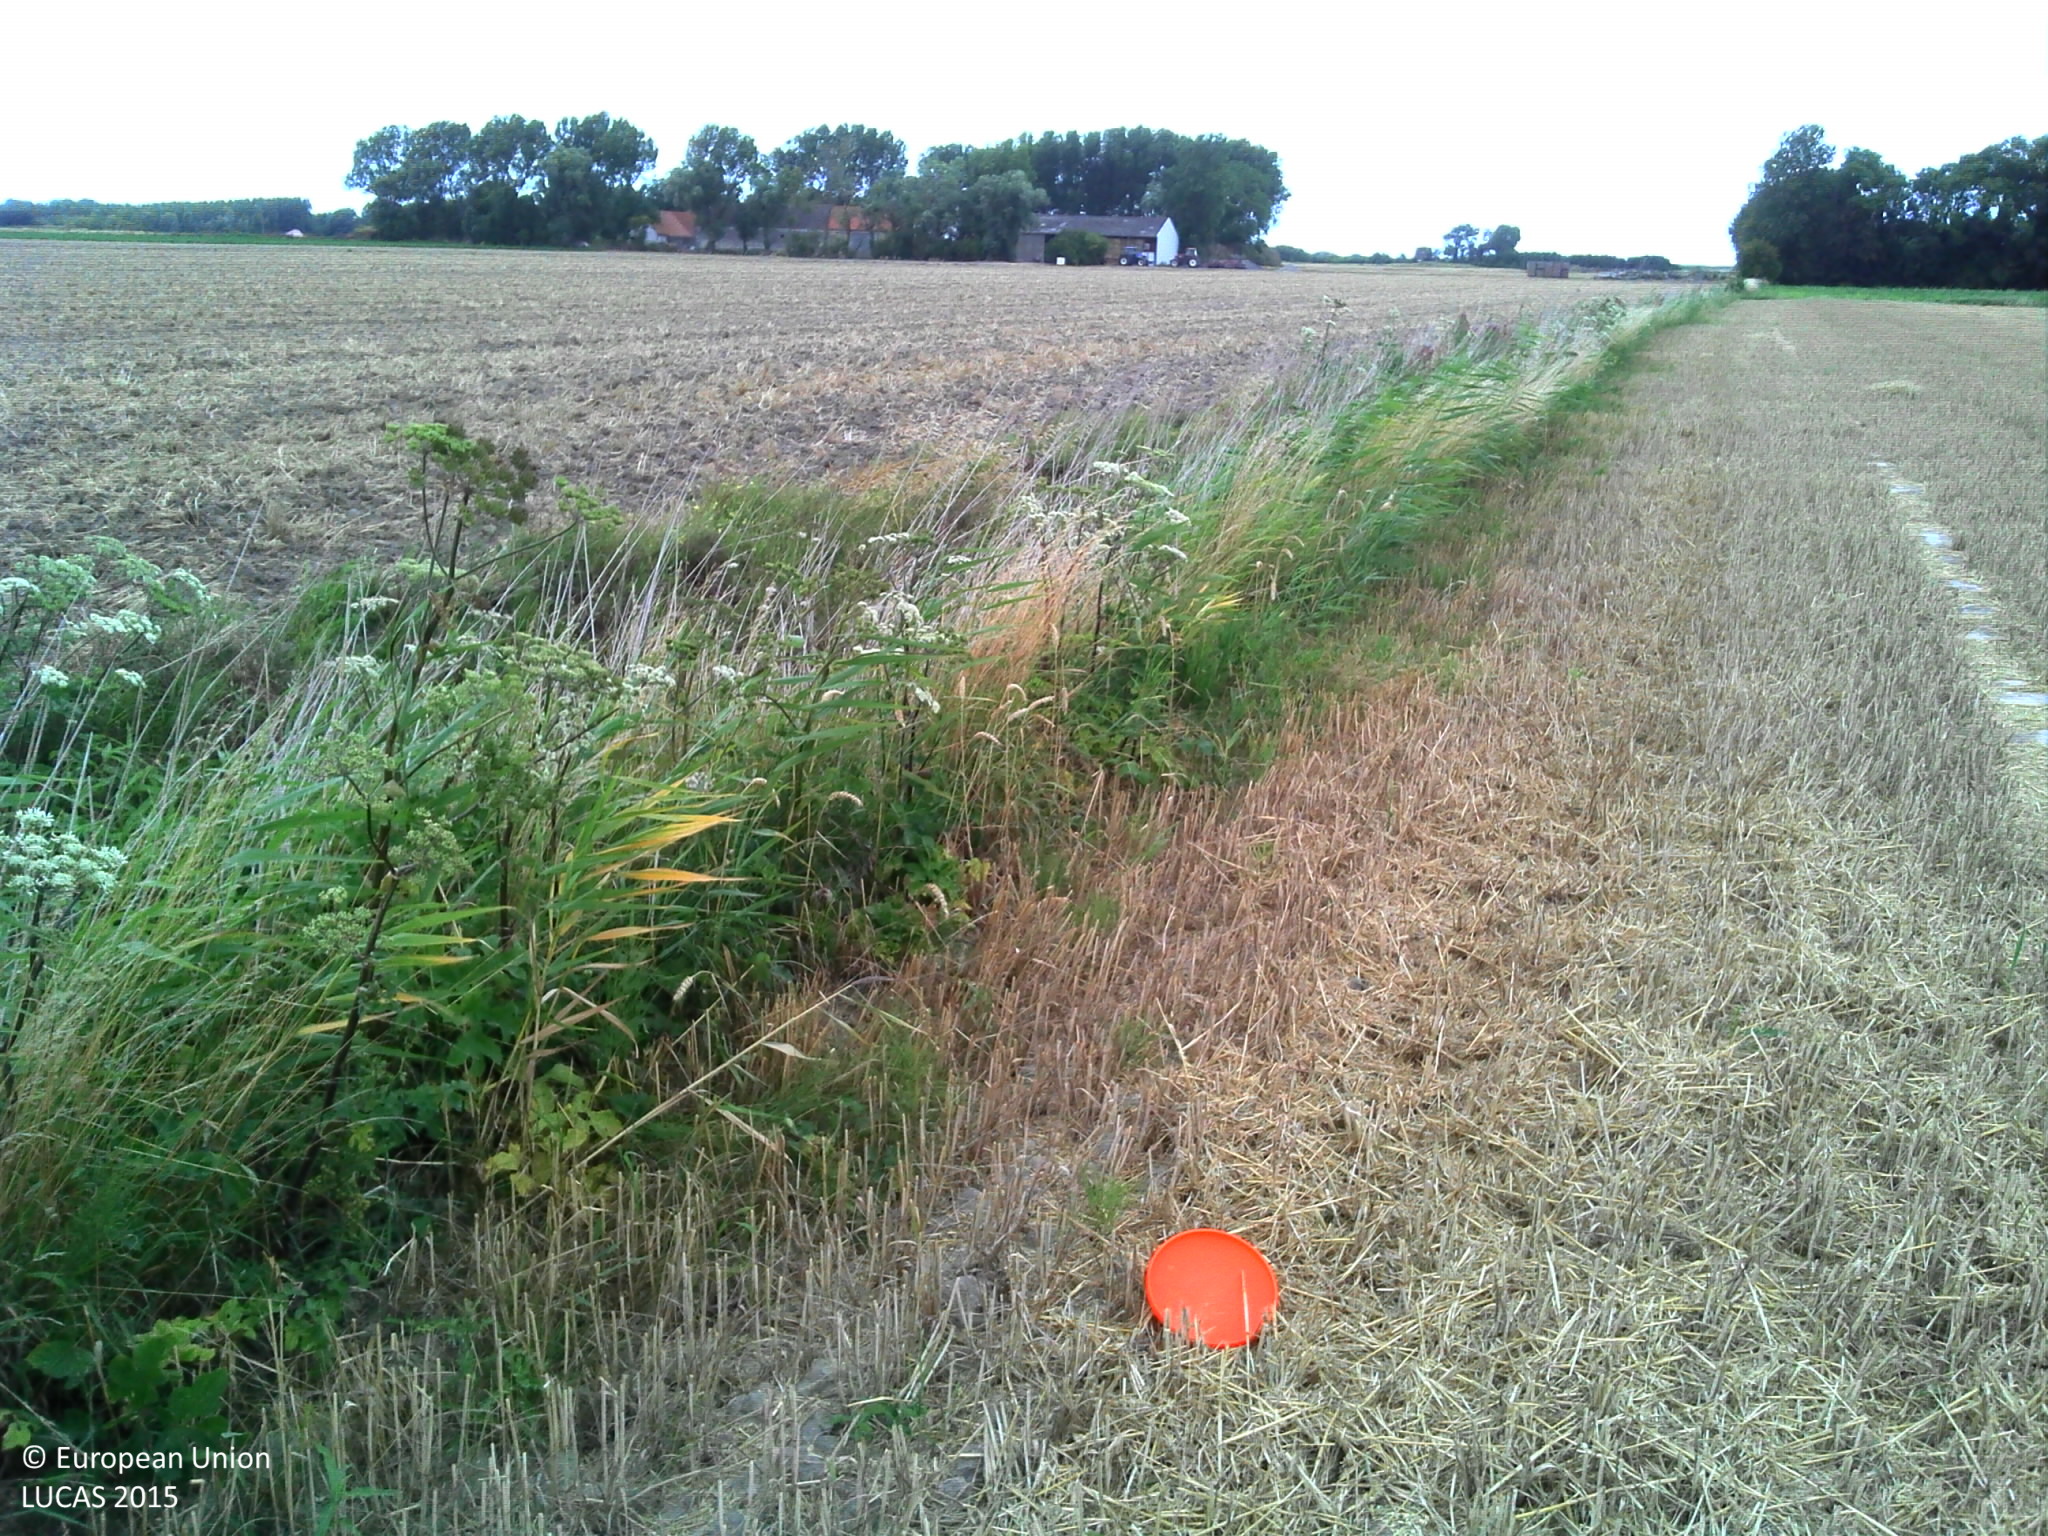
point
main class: Cropland
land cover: Common wheat
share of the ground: 50 - 75 %
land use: Agriculture (excluding fallow land and kitchen gardens)
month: August
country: FR
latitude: 50.9924
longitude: 2.0773
